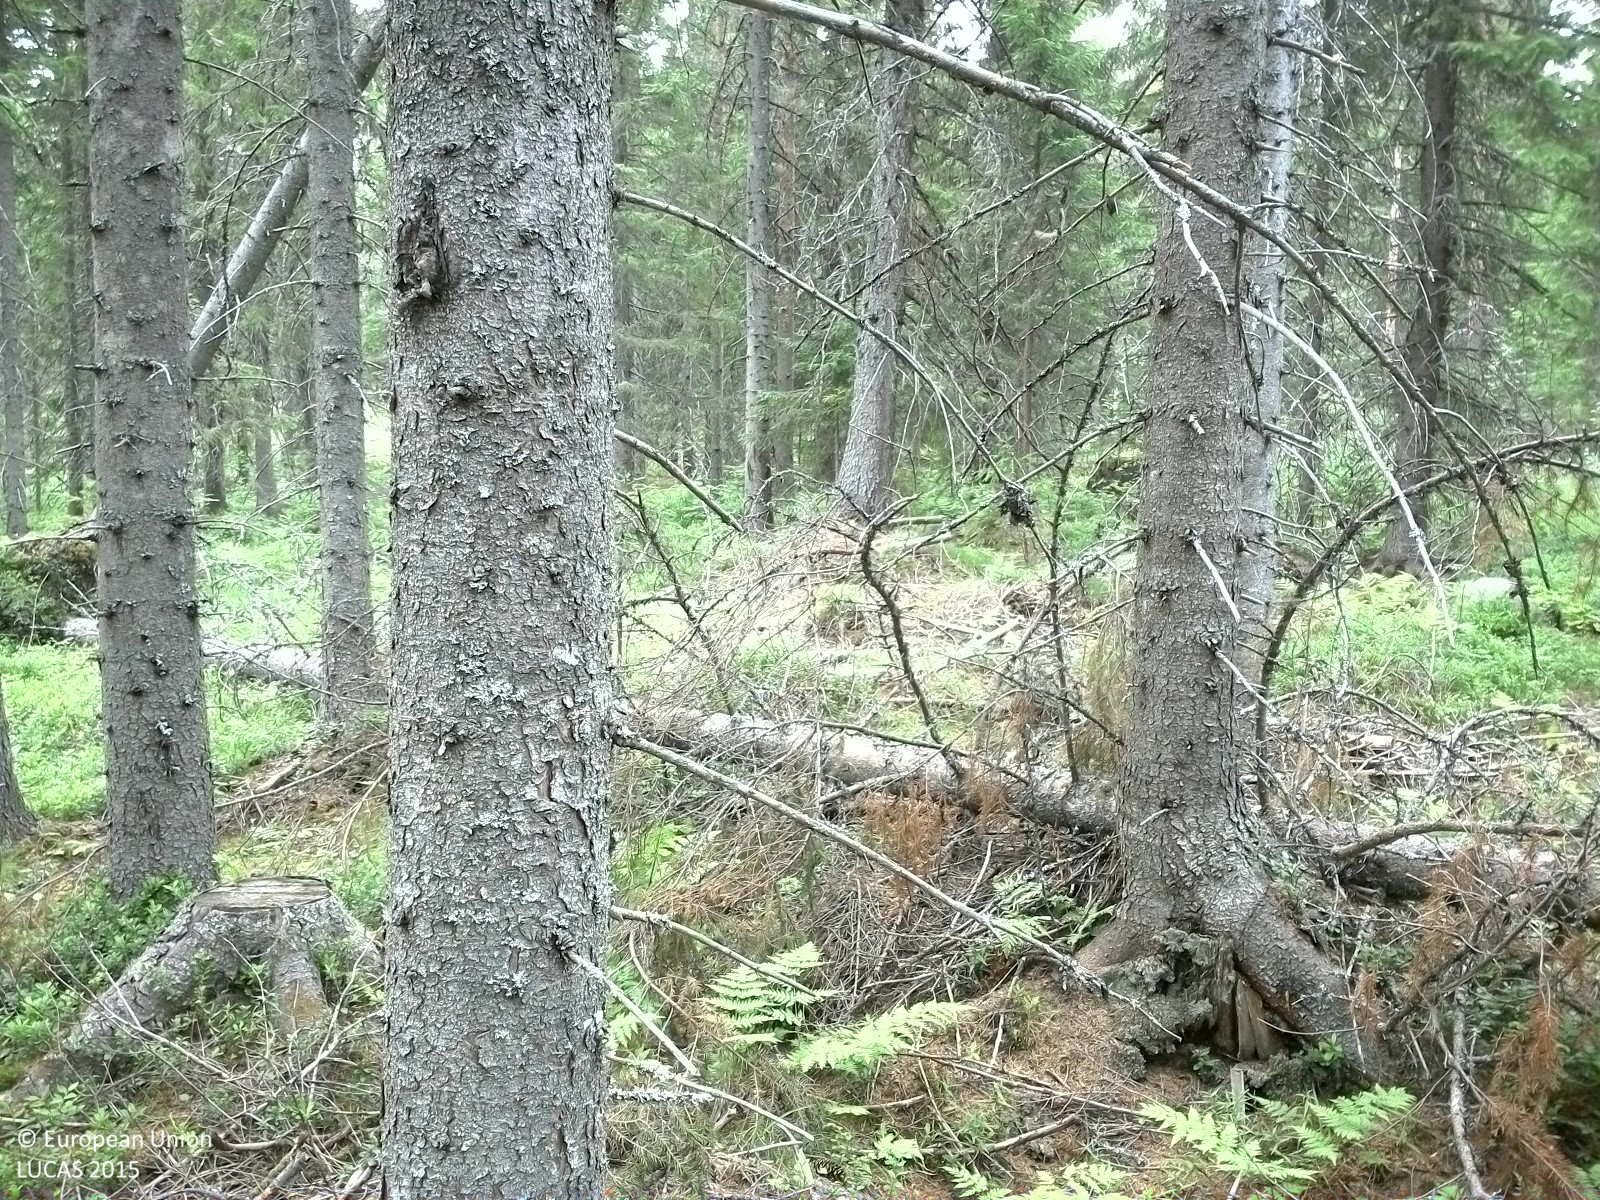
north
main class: Woodland
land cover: Spruce dominated coniferous woodland
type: boreal forest
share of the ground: 25 - 50 %
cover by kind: coniferous forest trees 45 %, shrubs 35 %, herbaceous plants 10 %, lichens and mosses 10 %
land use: Forestry
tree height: > 5 m
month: July
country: SE
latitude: 62.1246
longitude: 16.9793
